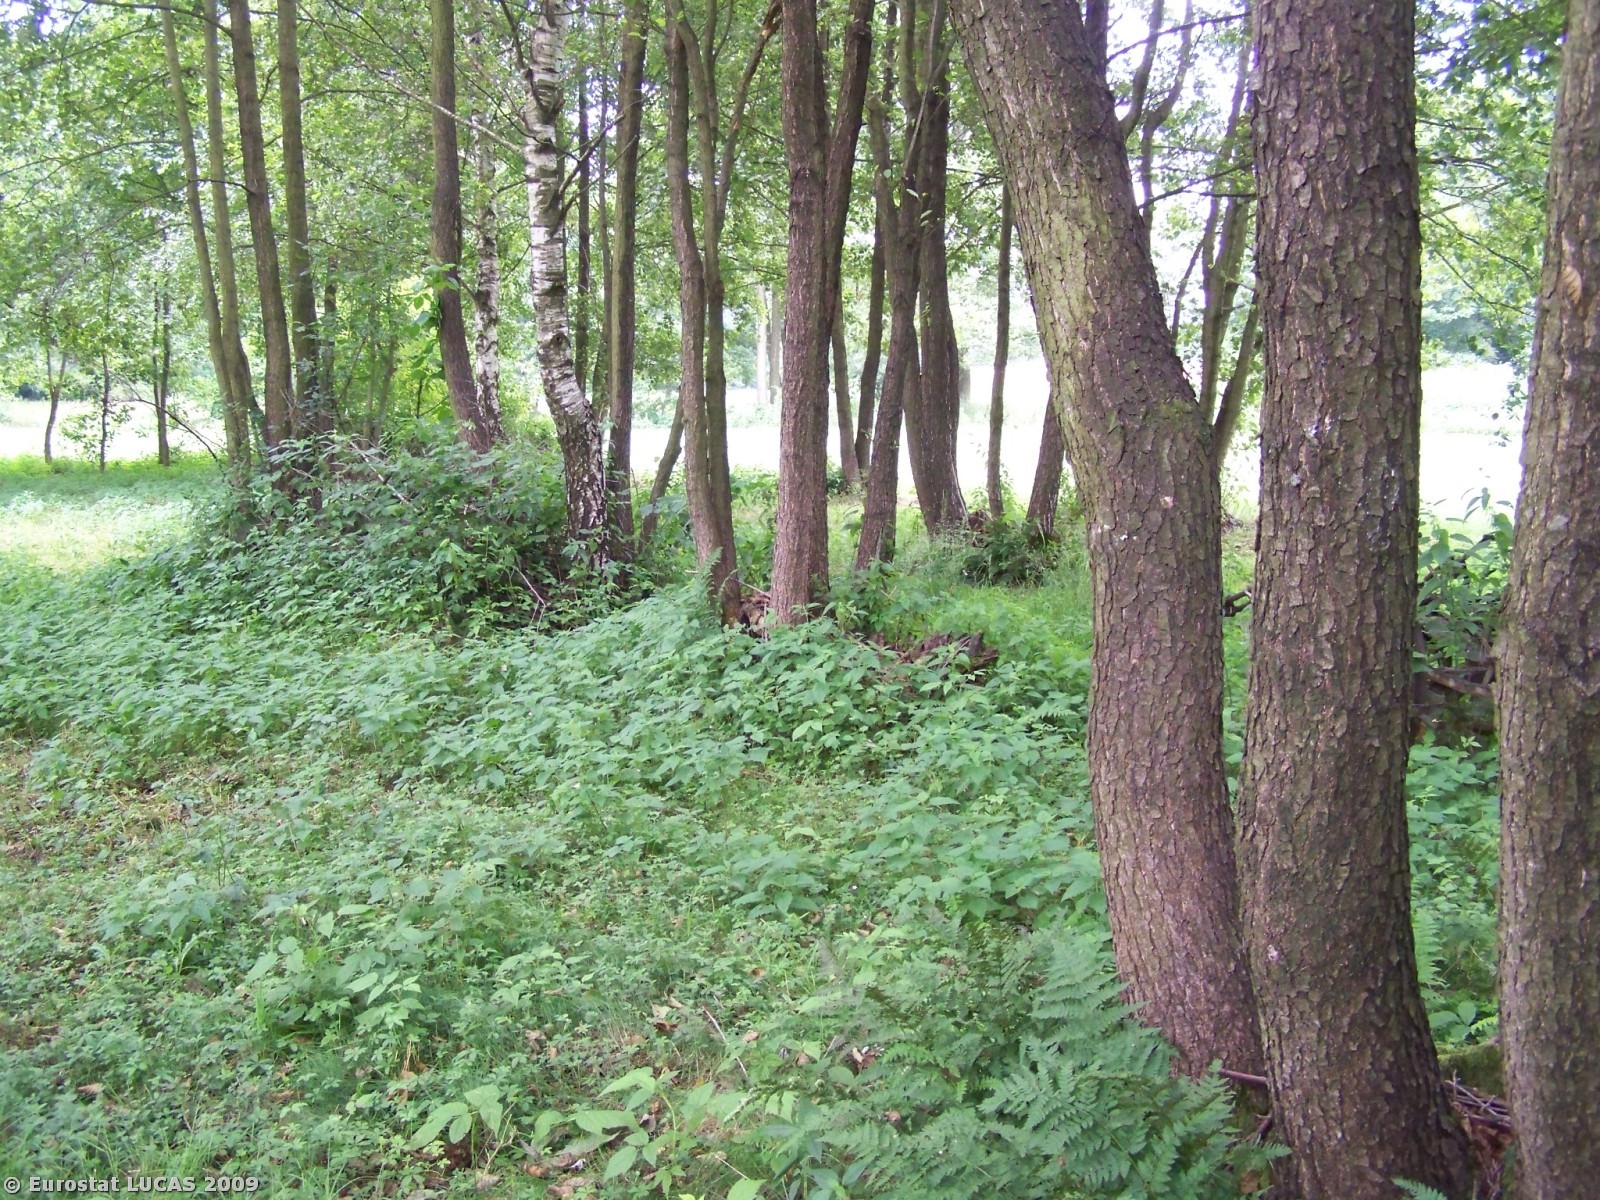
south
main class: Woodland
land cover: Broadleaved woodland
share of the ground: > 75 %
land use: Forestry
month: July
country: PL
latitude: 51.5052
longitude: 22.0606
